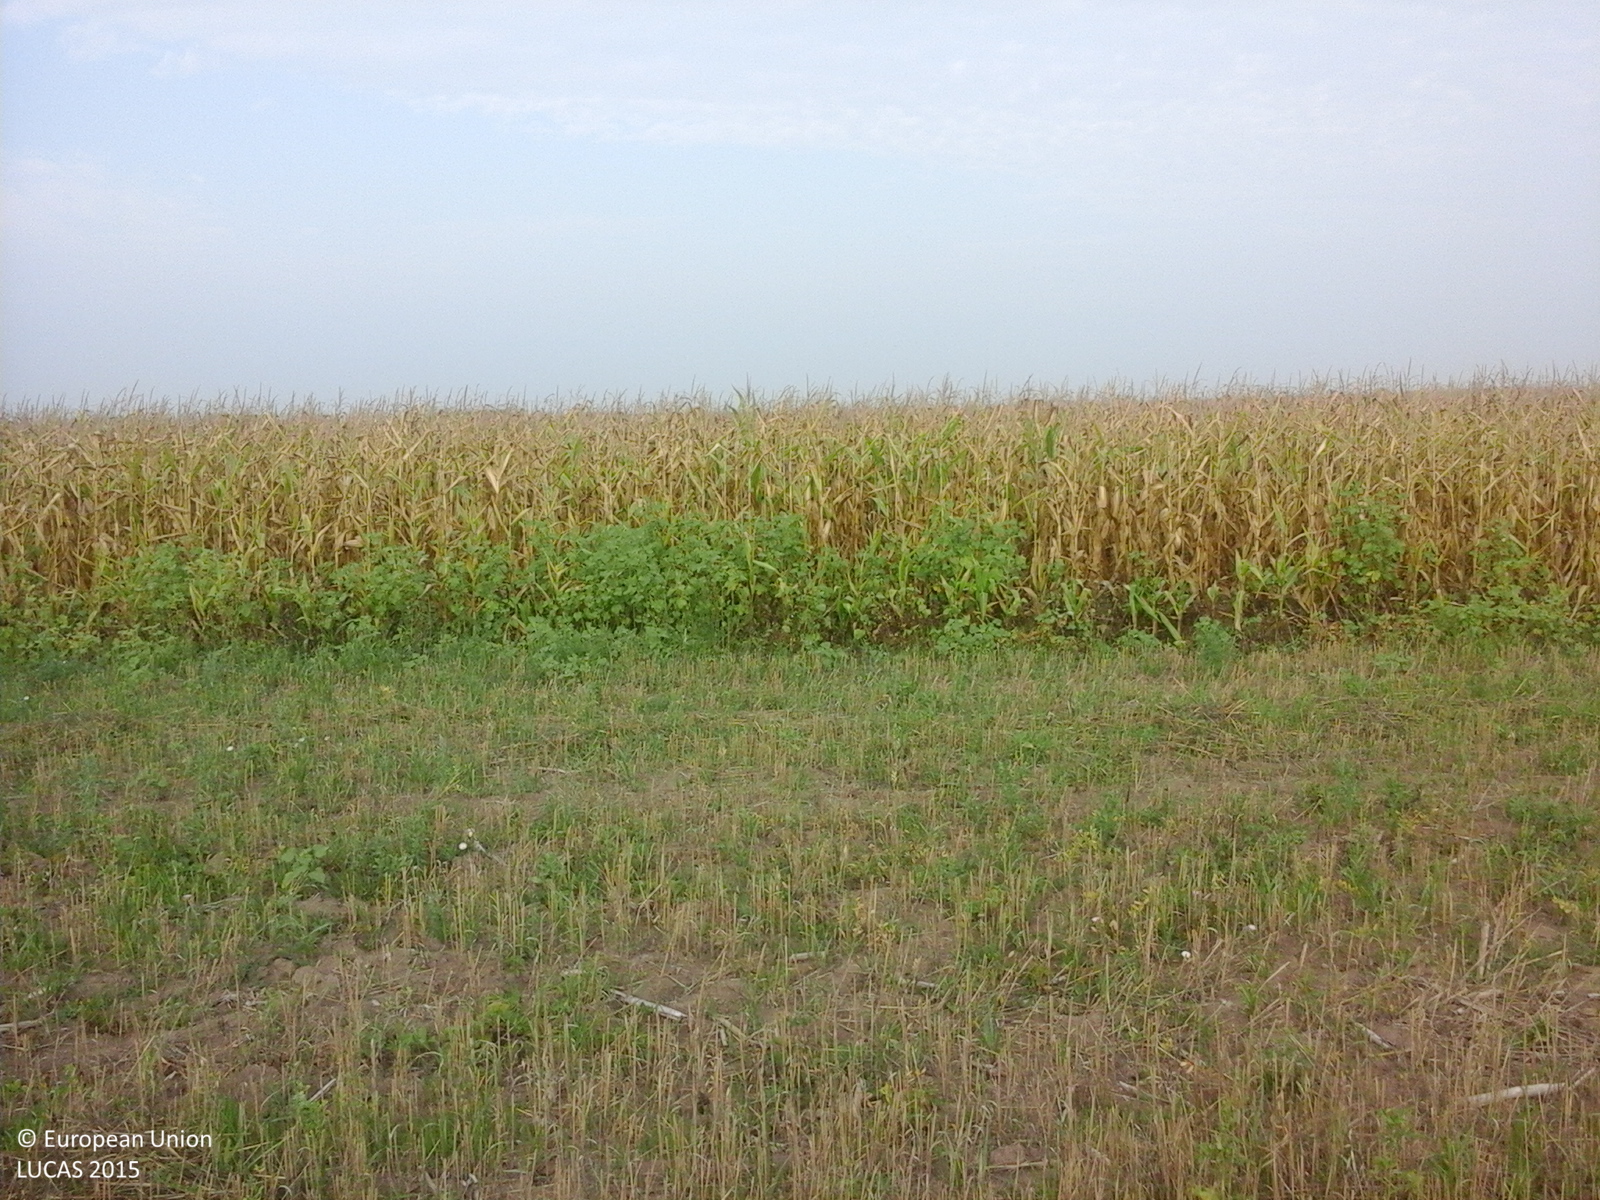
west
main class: Cropland
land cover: Oats
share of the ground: 25 - 50 %
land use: Agriculture (excluding fallow land and kitchen gardens)
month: August
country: RO
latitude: 46.3973
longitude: 21.7061
